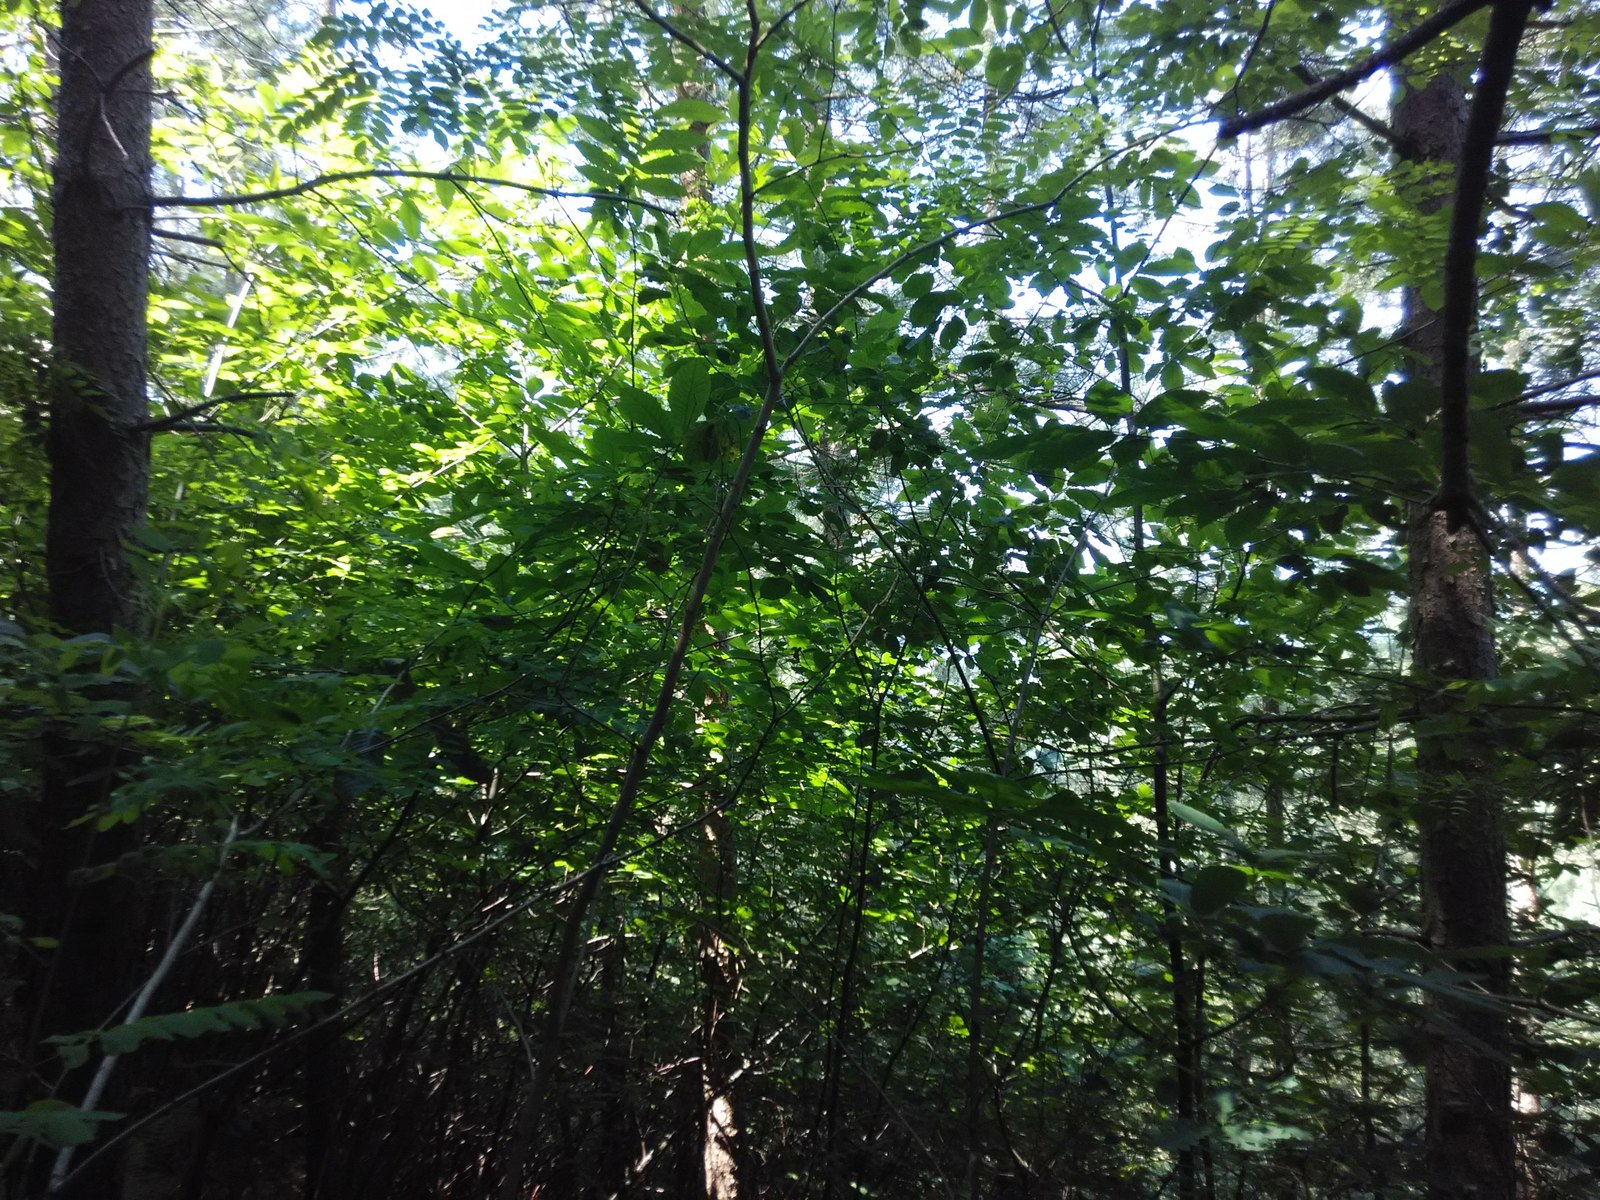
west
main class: Woodland
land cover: Pine dominated mixed woodland
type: exotic forest
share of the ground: > 75 %
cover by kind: coniferous forest trees 70 %, broadleaved forest trees 30 %
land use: Forestry
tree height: > 5 m
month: June
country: ES
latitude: 43.0401
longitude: -2.3856
